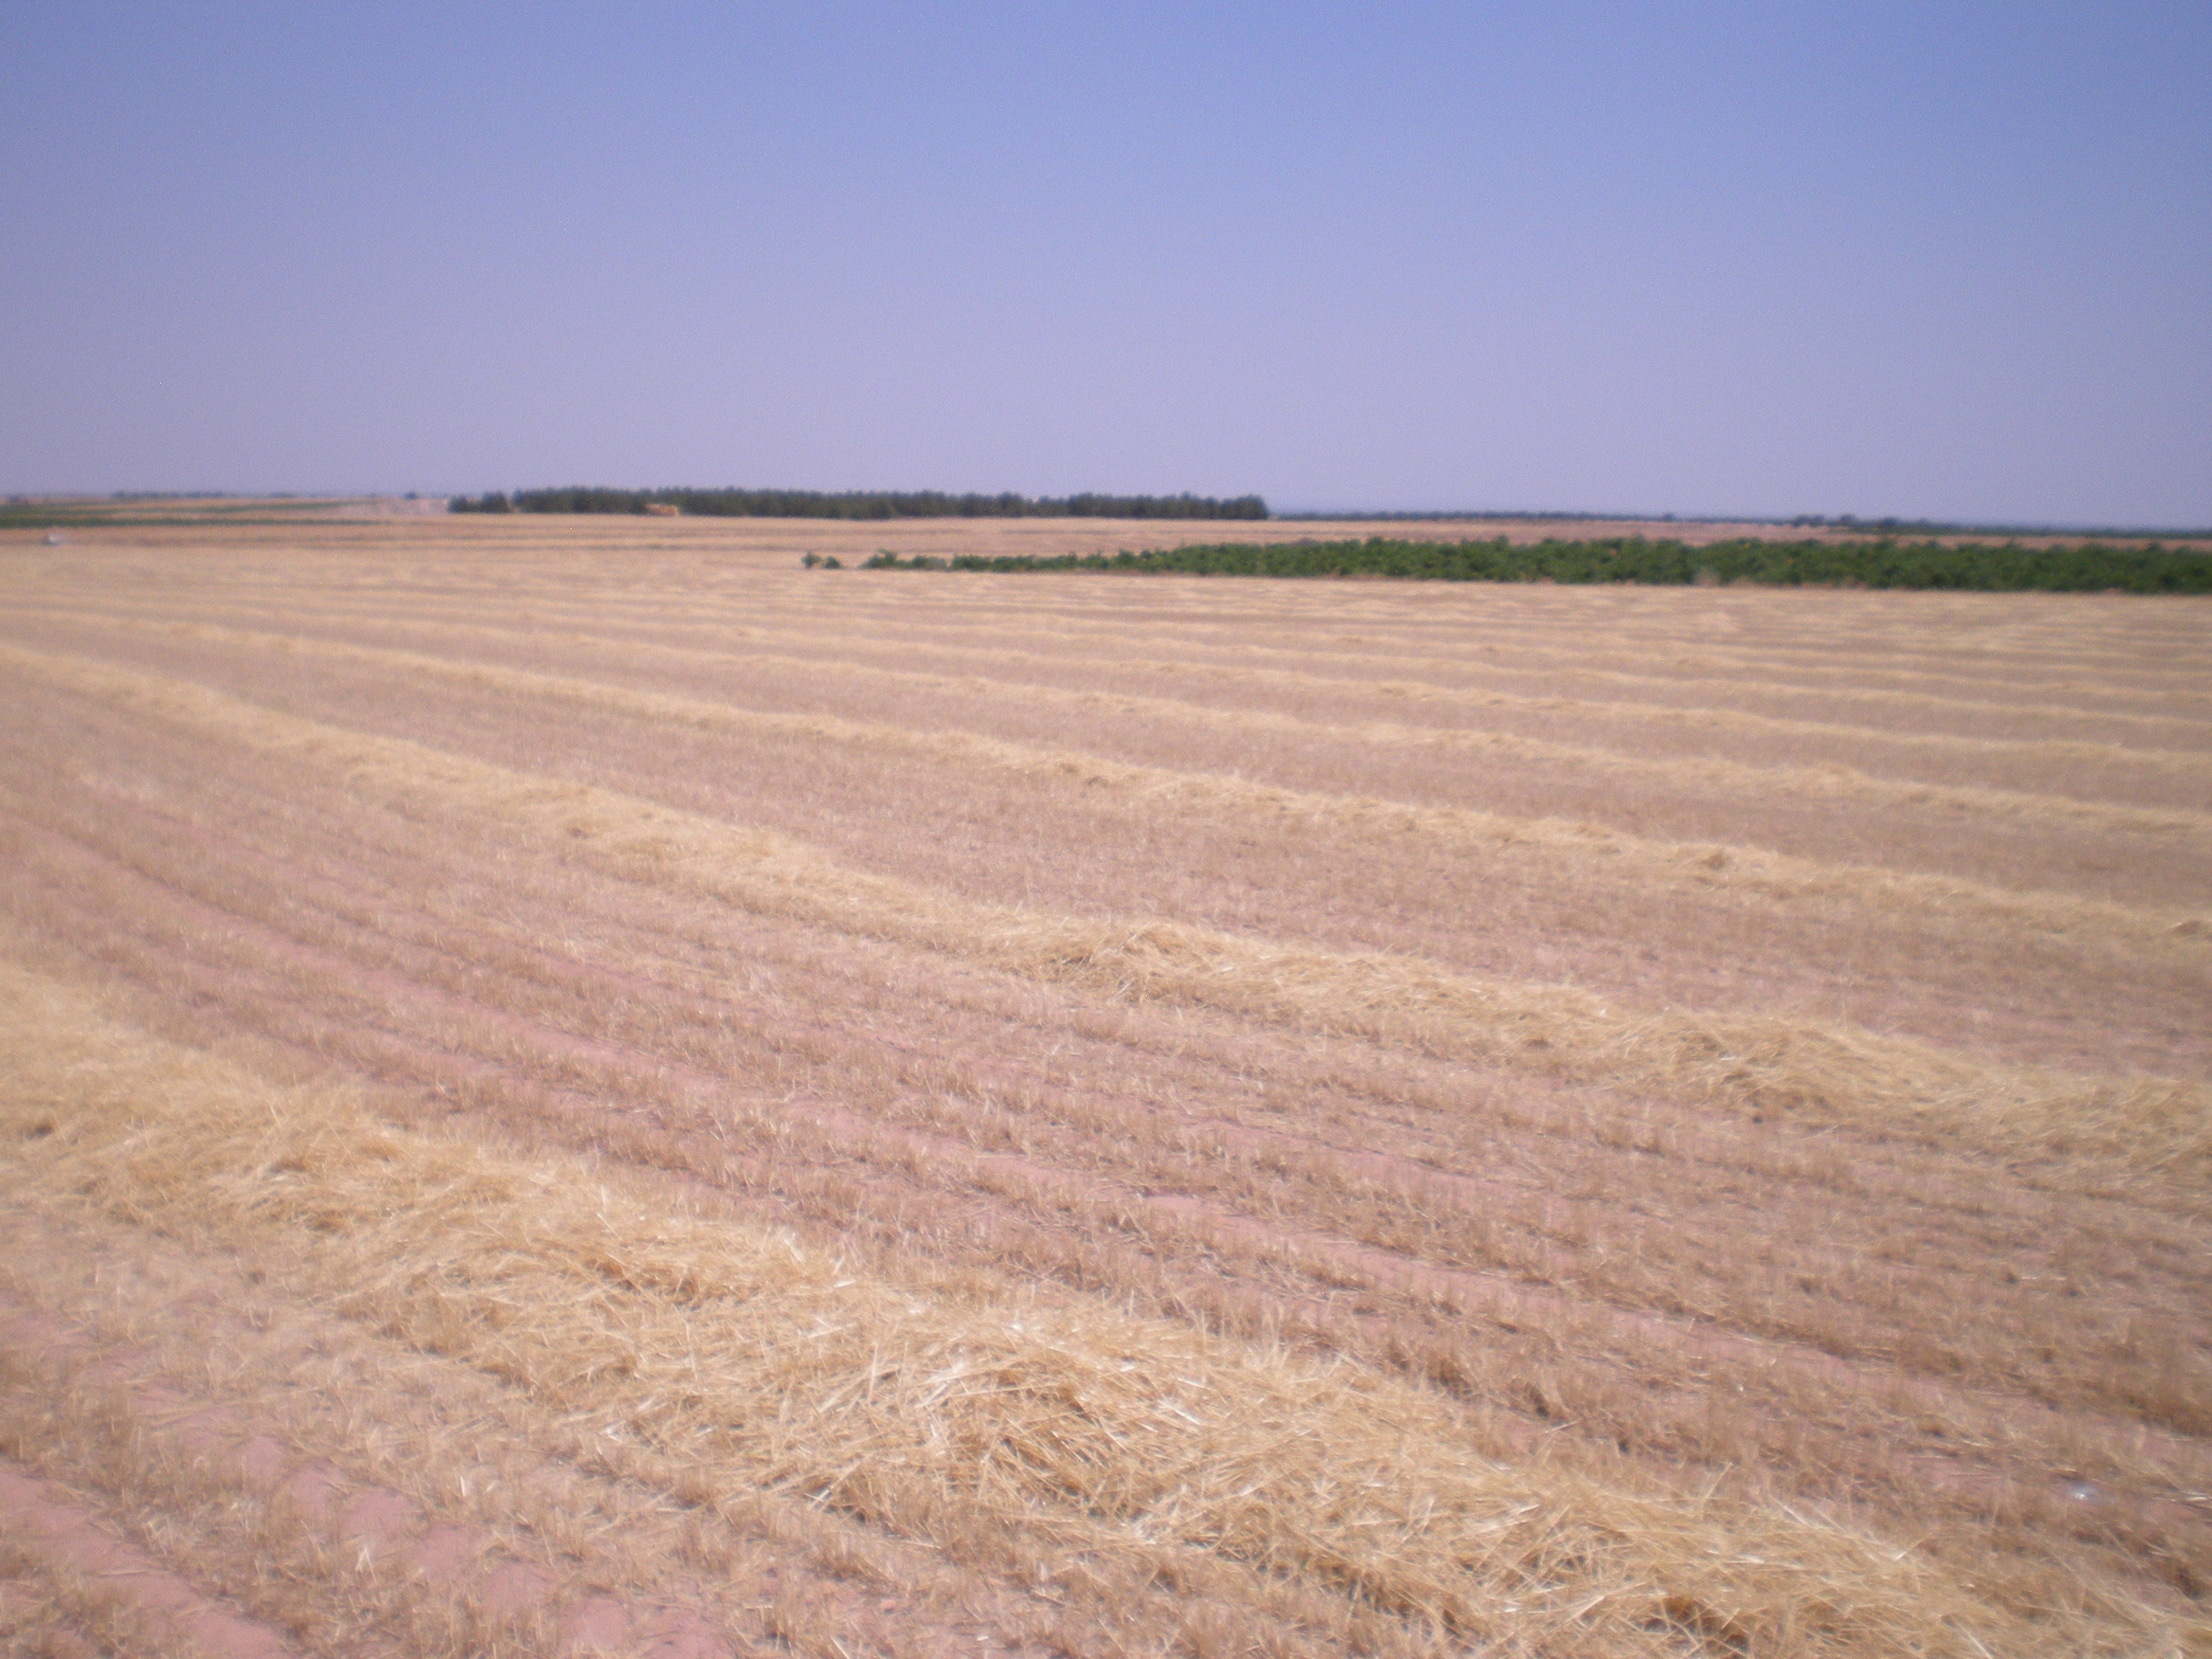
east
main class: Cropland
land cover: Barley
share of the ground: < 10 %
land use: Agriculture (excluding fallow land and kitchen gardens)
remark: Harvested field
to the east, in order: Barley; Grass margins; Vineyards; Grass margins; Barley; Grass margins; Oats
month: June
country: ES
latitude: 39.6592
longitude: -3.3689
